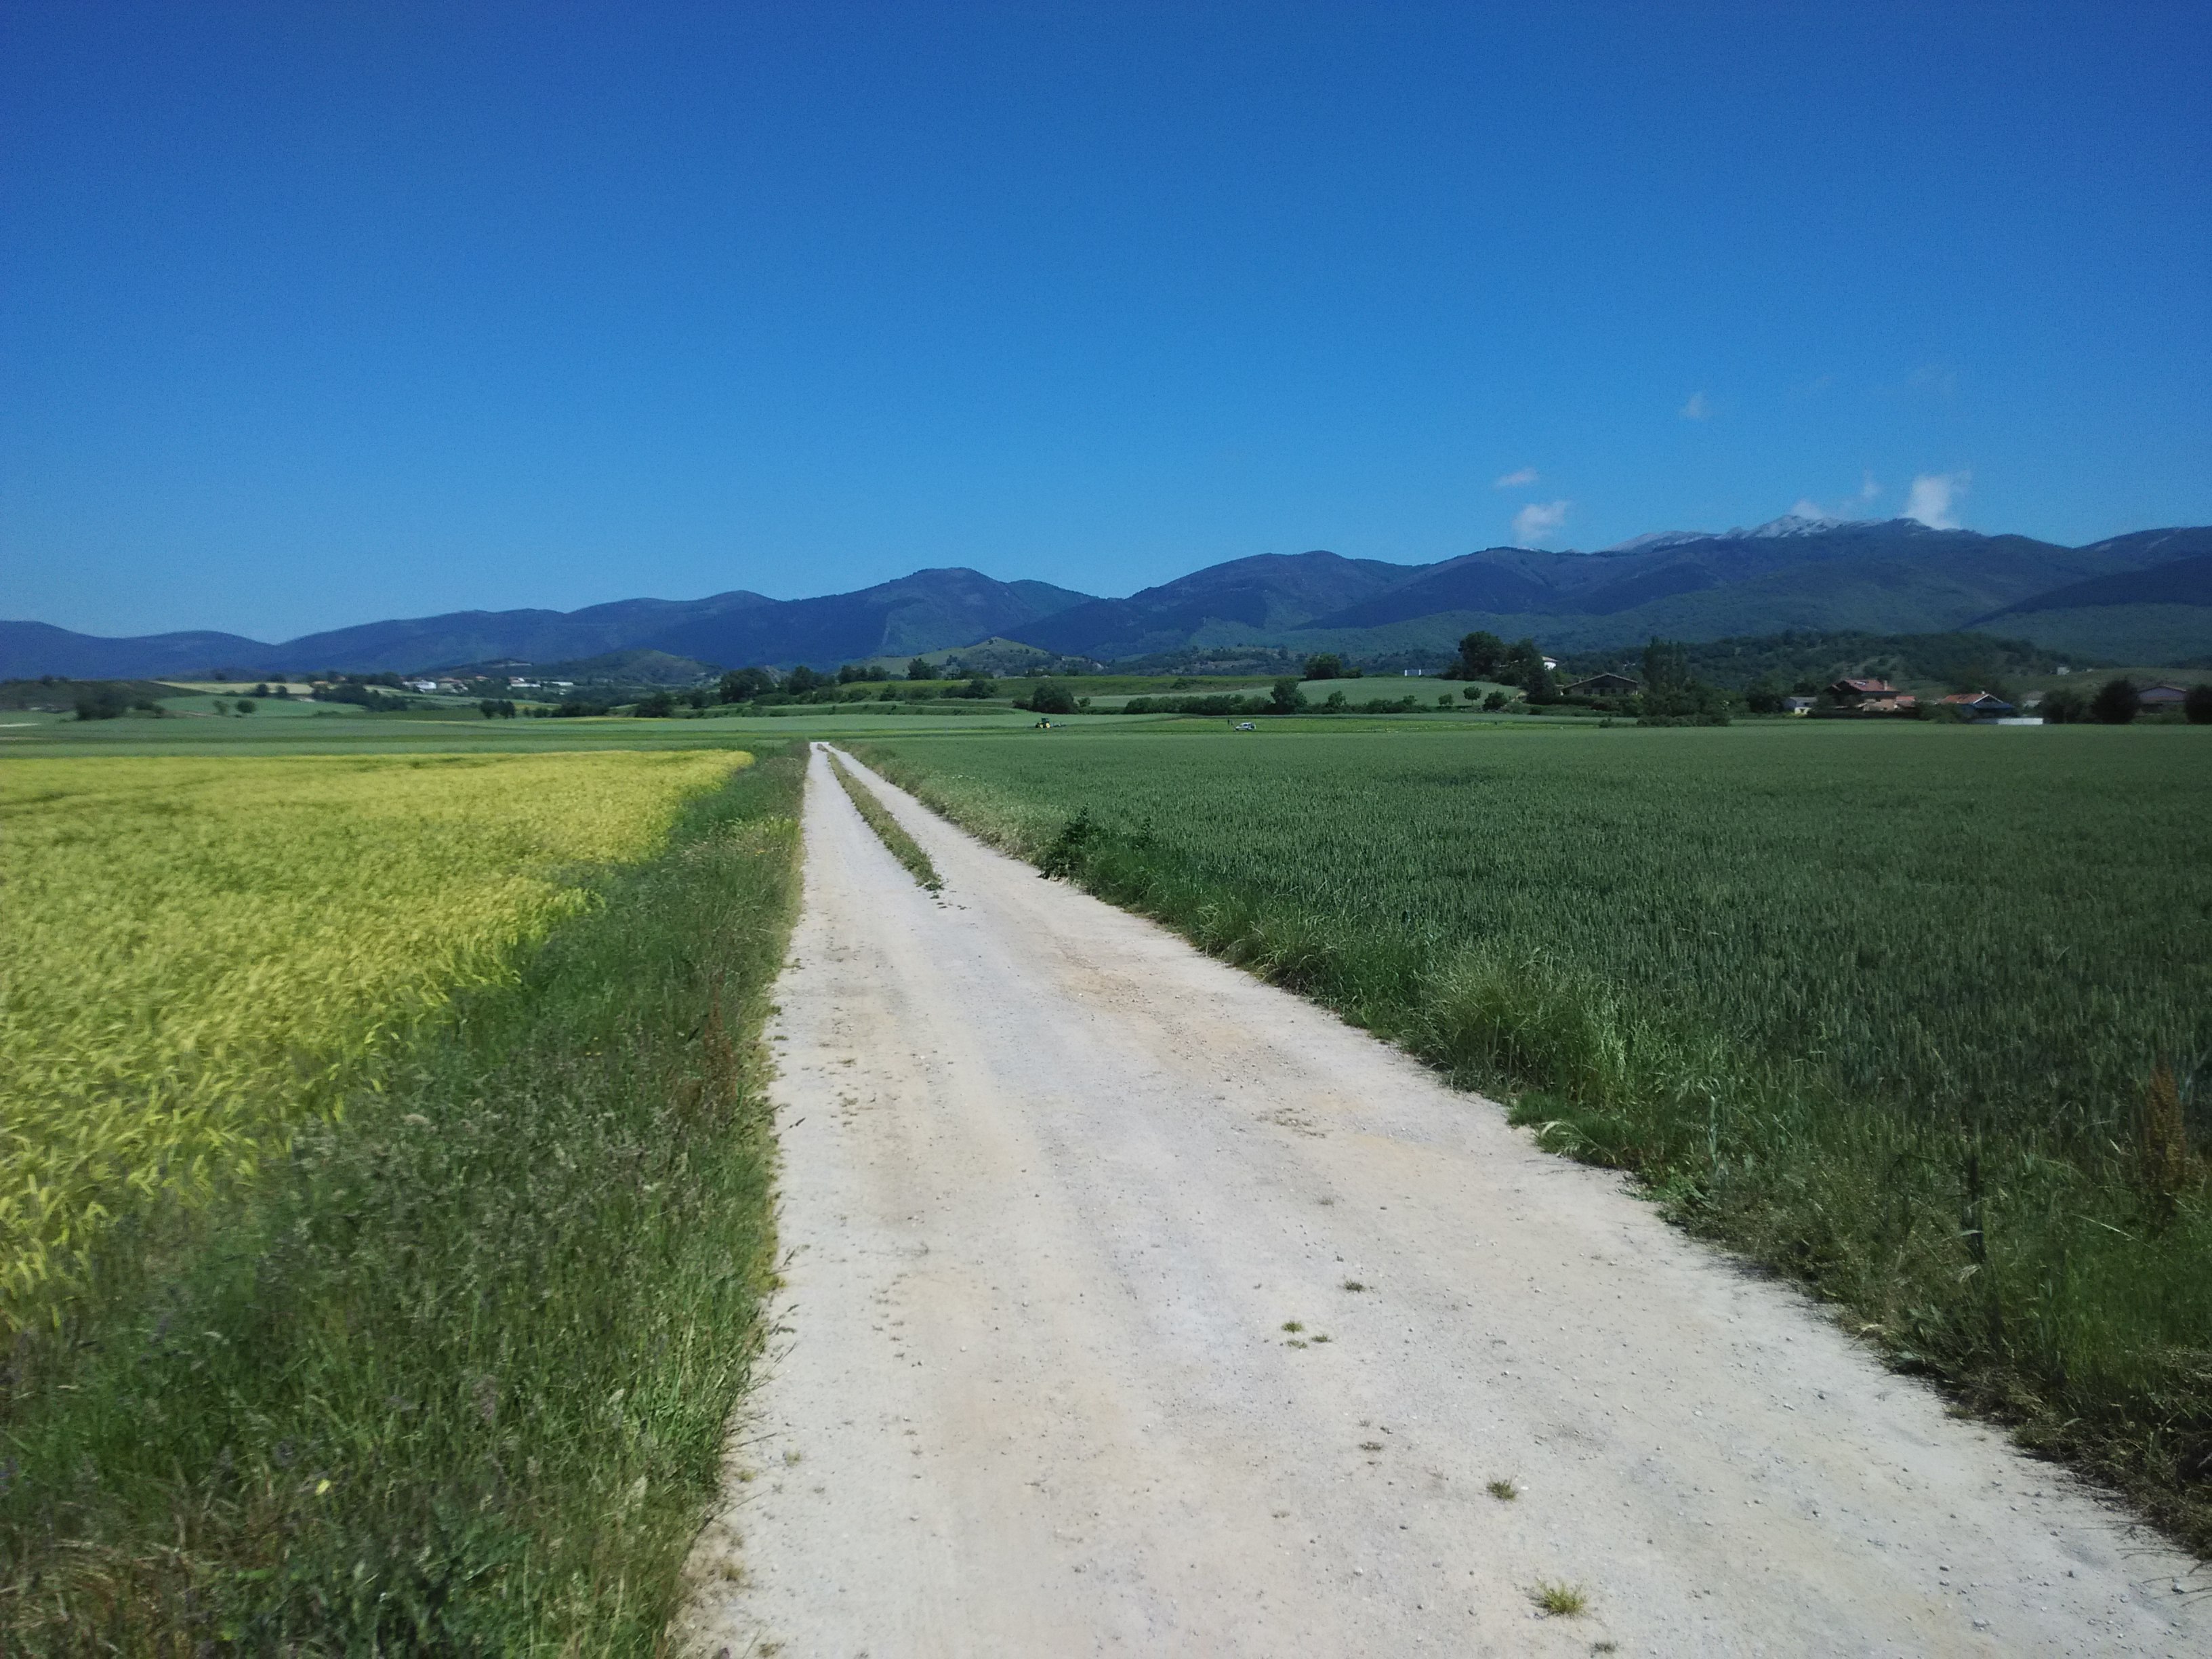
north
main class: Cropland
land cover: Barley
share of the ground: > 75 %
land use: Agriculture (excluding fallow land and kitchen gardens)
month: June
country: ES
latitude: 42.8801
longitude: -2.3518
